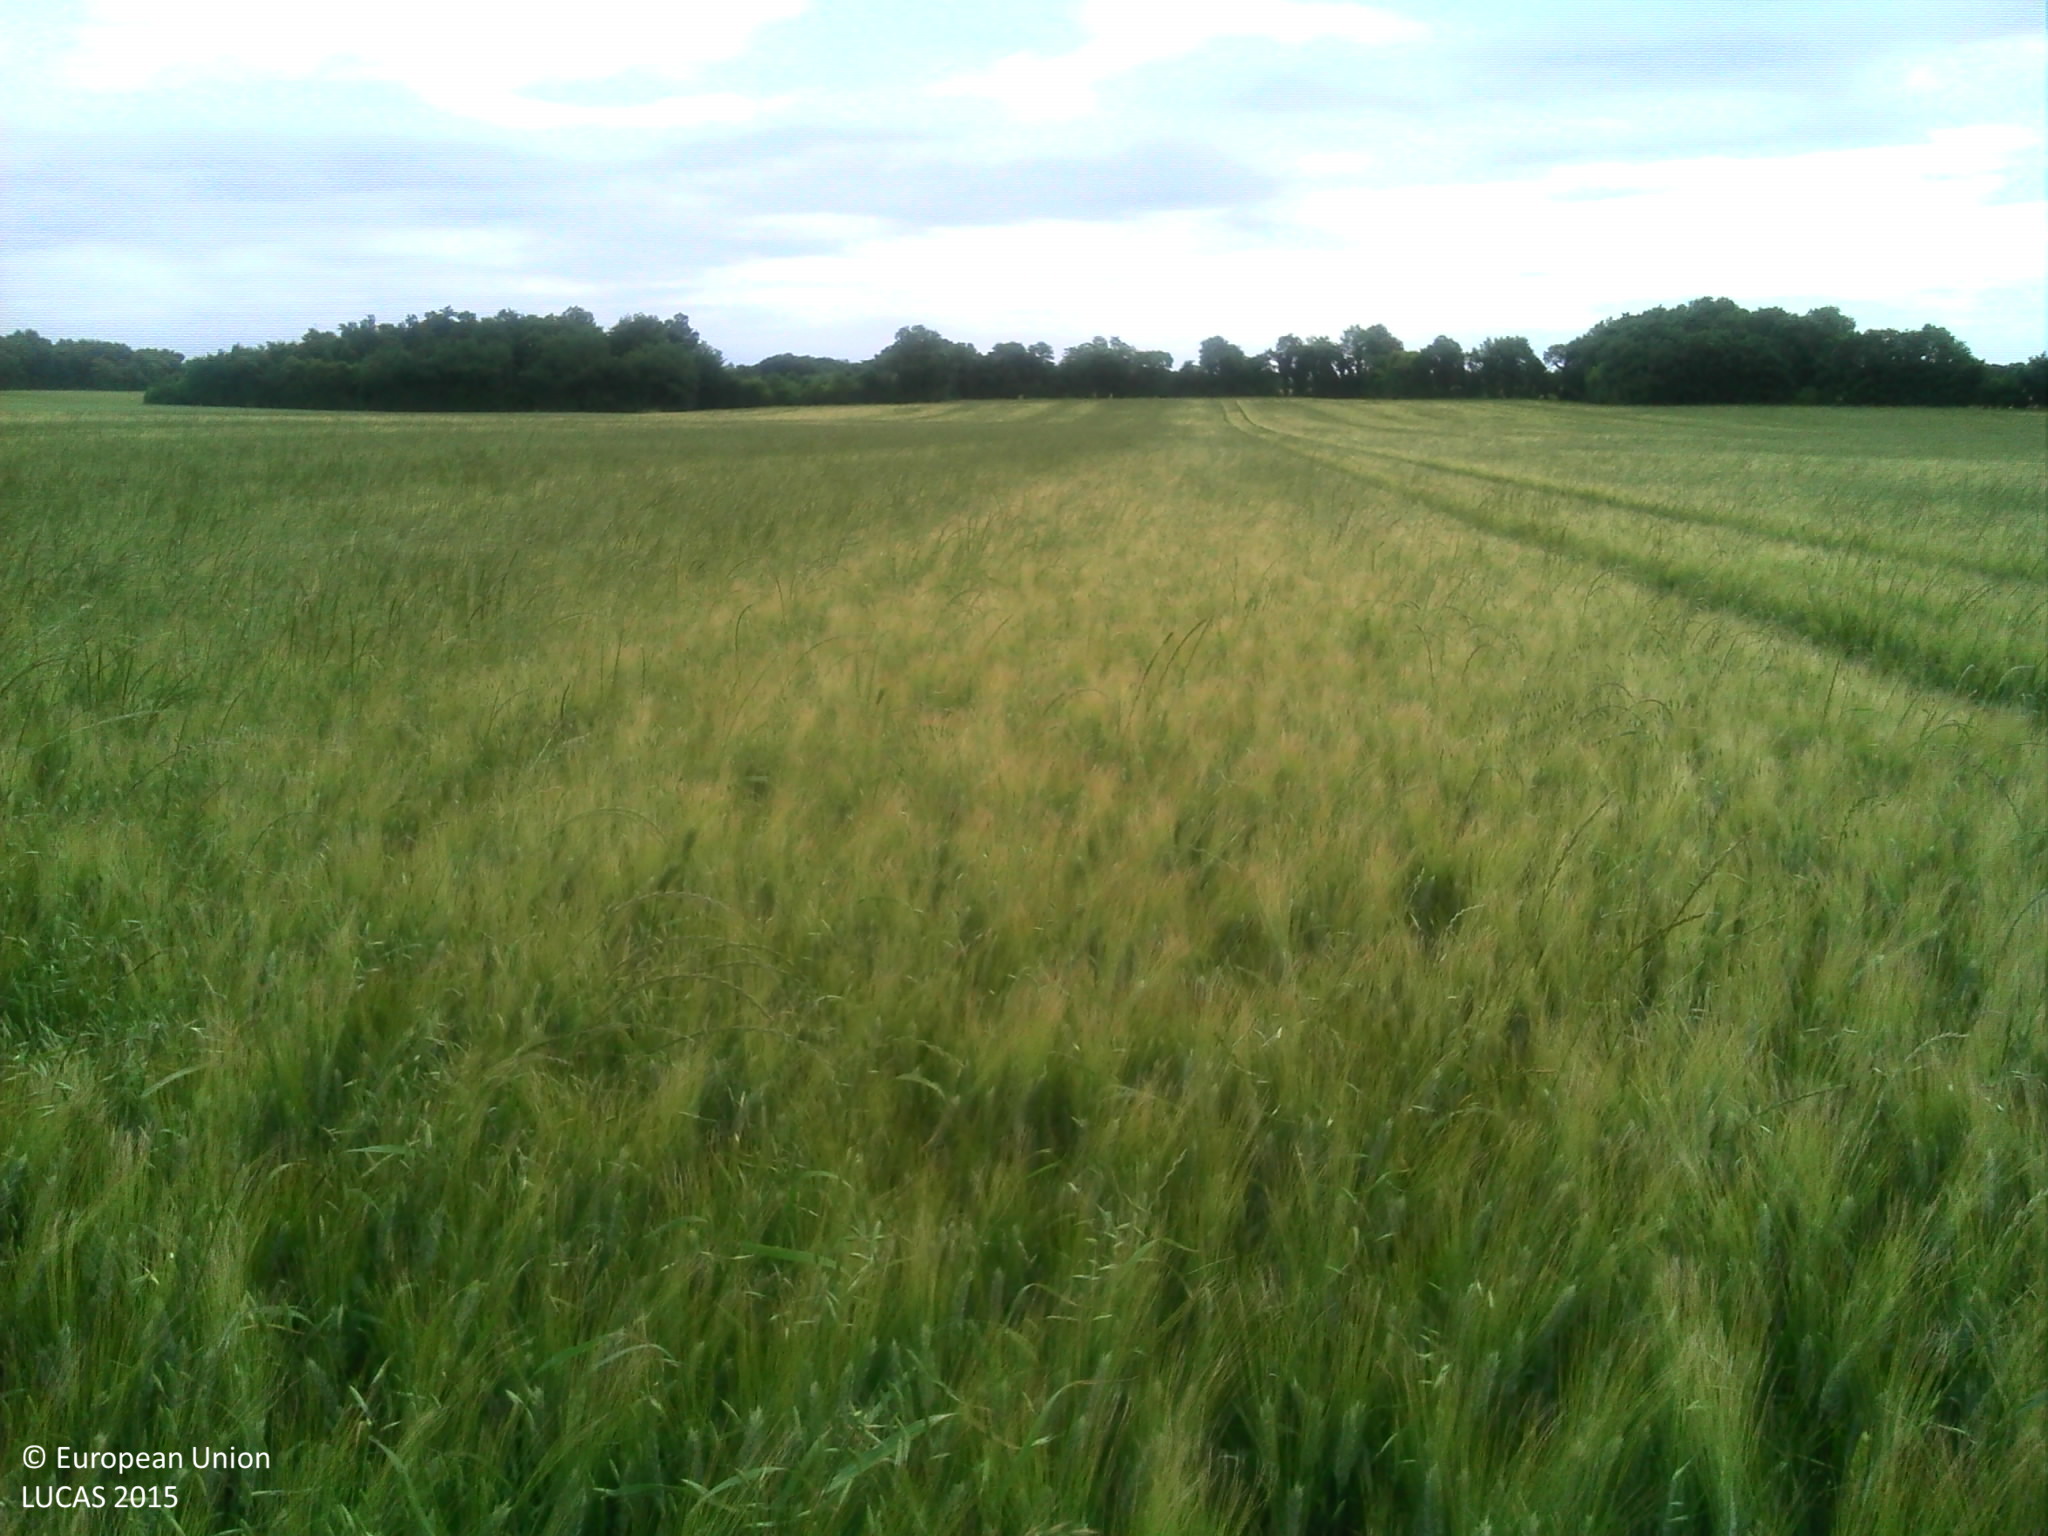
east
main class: Cropland
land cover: Durum wheat
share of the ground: > 75 %
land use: Agriculture (excluding fallow land and kitchen gardens)
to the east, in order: Durum wheat
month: June
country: FR
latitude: 46.1334
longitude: -0.9408
